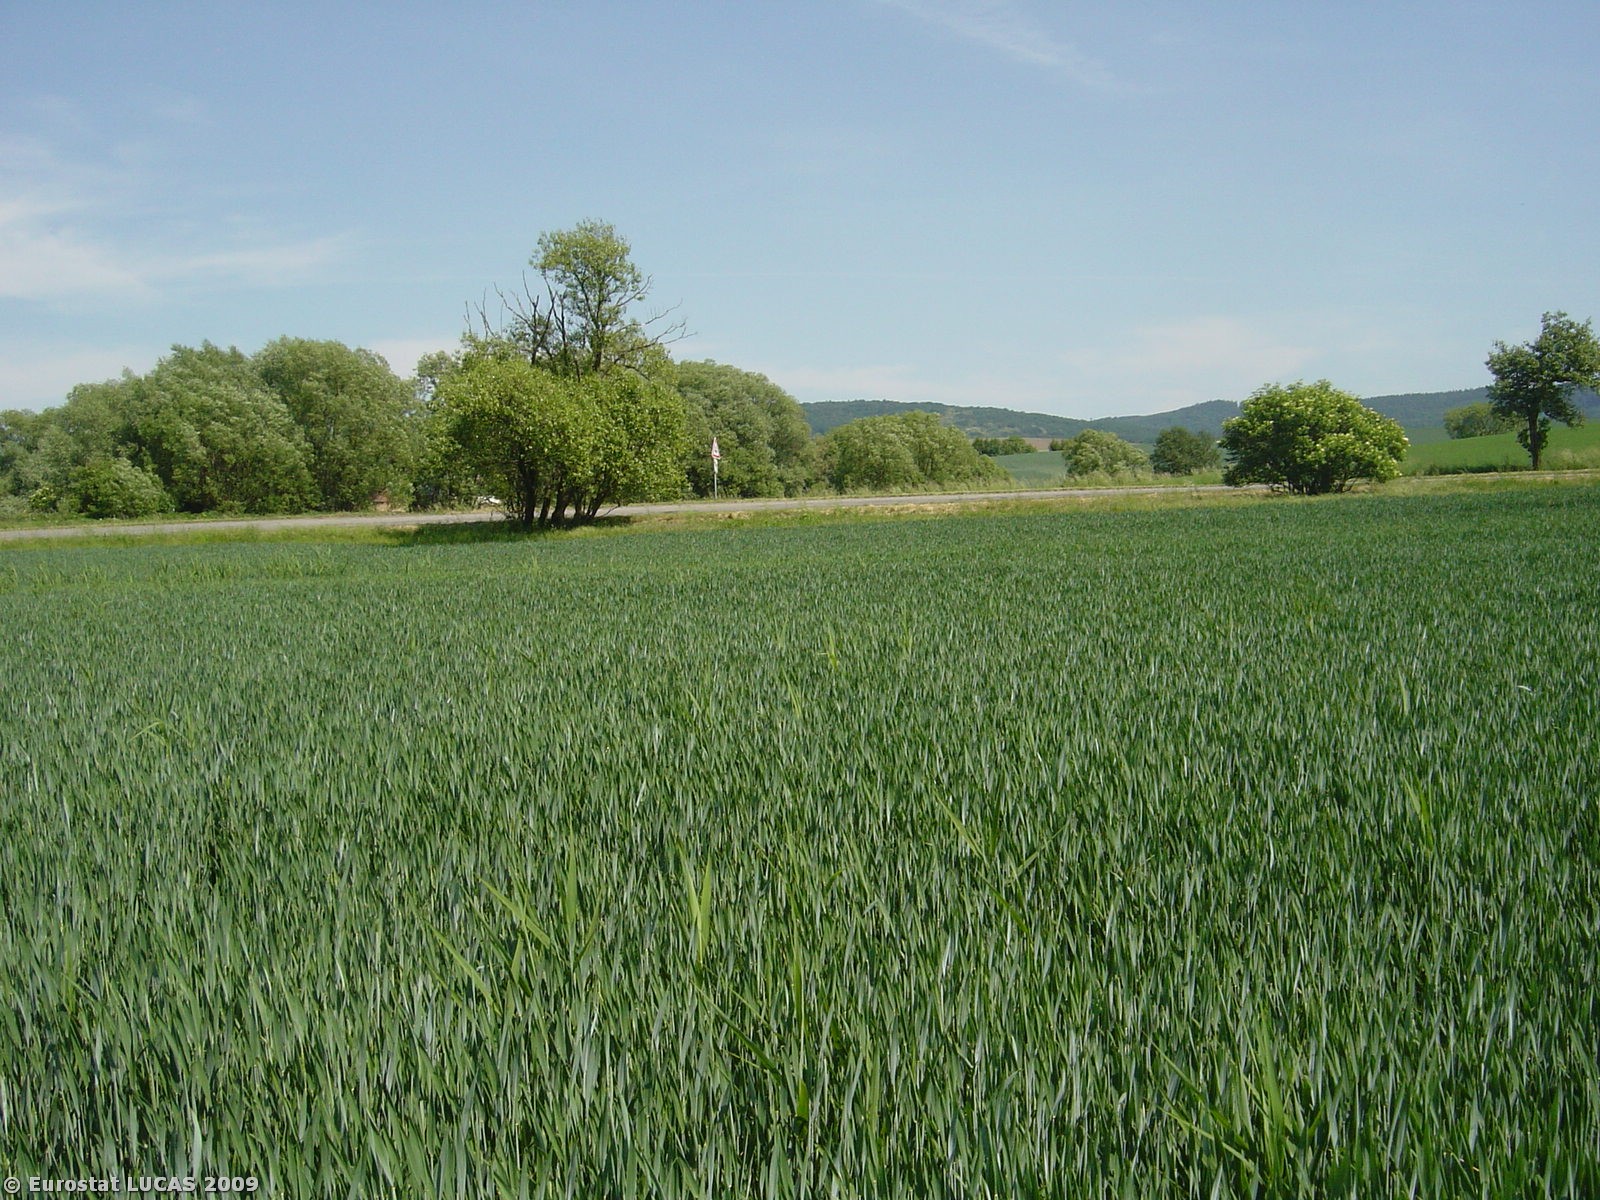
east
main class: Cropland
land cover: Common wheat
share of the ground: > 75 %
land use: Agriculture (excluding fallow land and kitchen gardens)
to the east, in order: Common wheat; Electric lines; Common wheat; Lines of trees; Paved roads, cycling and walking lanes; Grass margins; Barley
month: May
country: CZ
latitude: 49.1614
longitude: 17.2096
